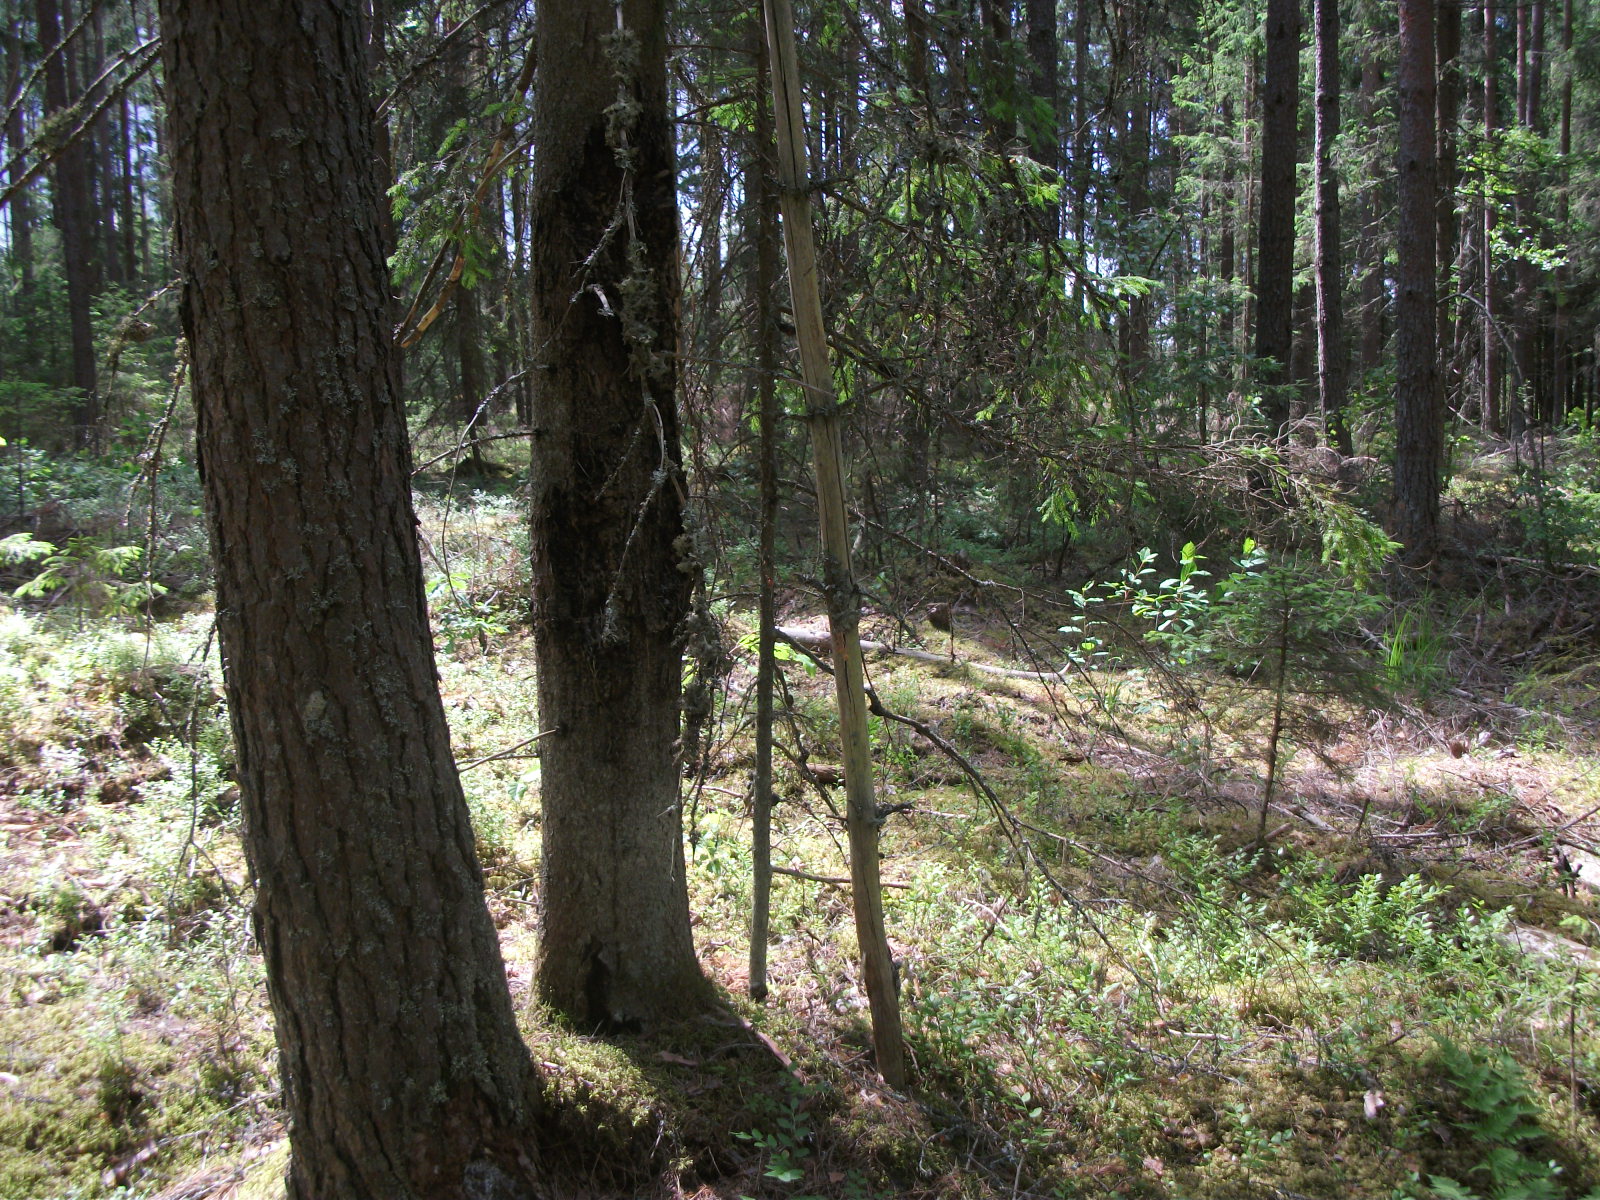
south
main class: Woodland
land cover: Other coniferous woodland
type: hemiboreal forest and nemoral coniferous forest and mixed broadleaved-coniferous forest
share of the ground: > 75 %
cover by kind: coniferous forest trees 85 %, lichens and mosses 10 %, shrubs 5 %
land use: Forestry
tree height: > 5 m
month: July
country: LV
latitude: 57.0818
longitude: 26.3253
